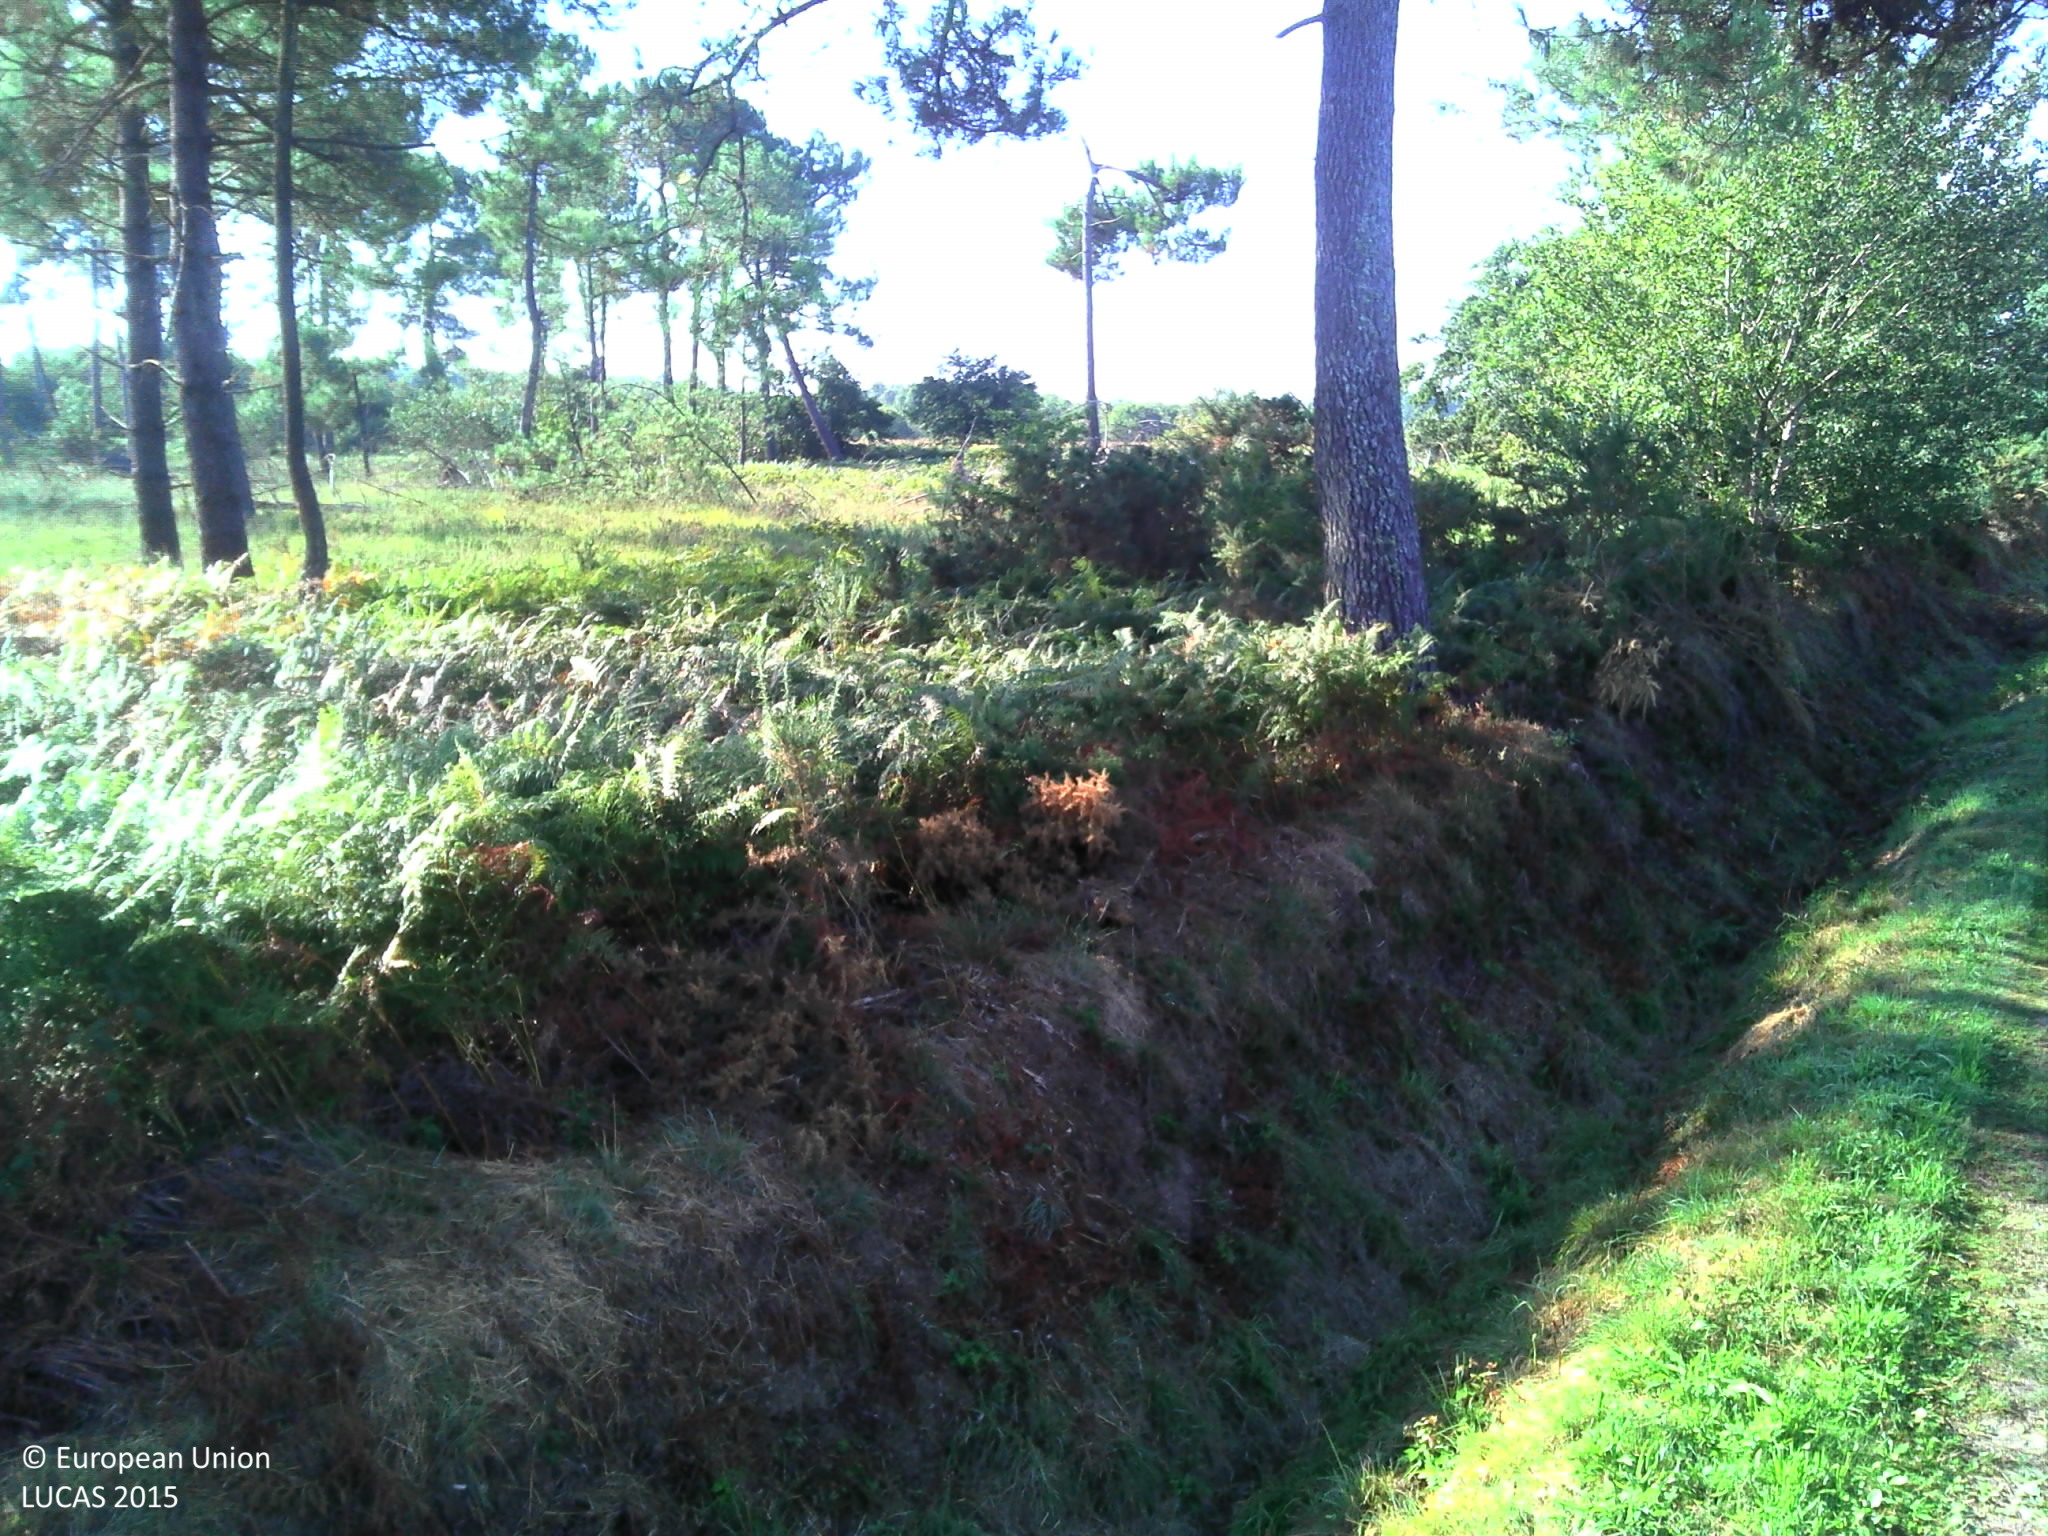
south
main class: Cropland
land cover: Maize
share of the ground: > 75 %
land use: Agriculture (excluding fallow land and kitchen gardens)
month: September
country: FR
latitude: 43.5547
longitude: -0.7440
